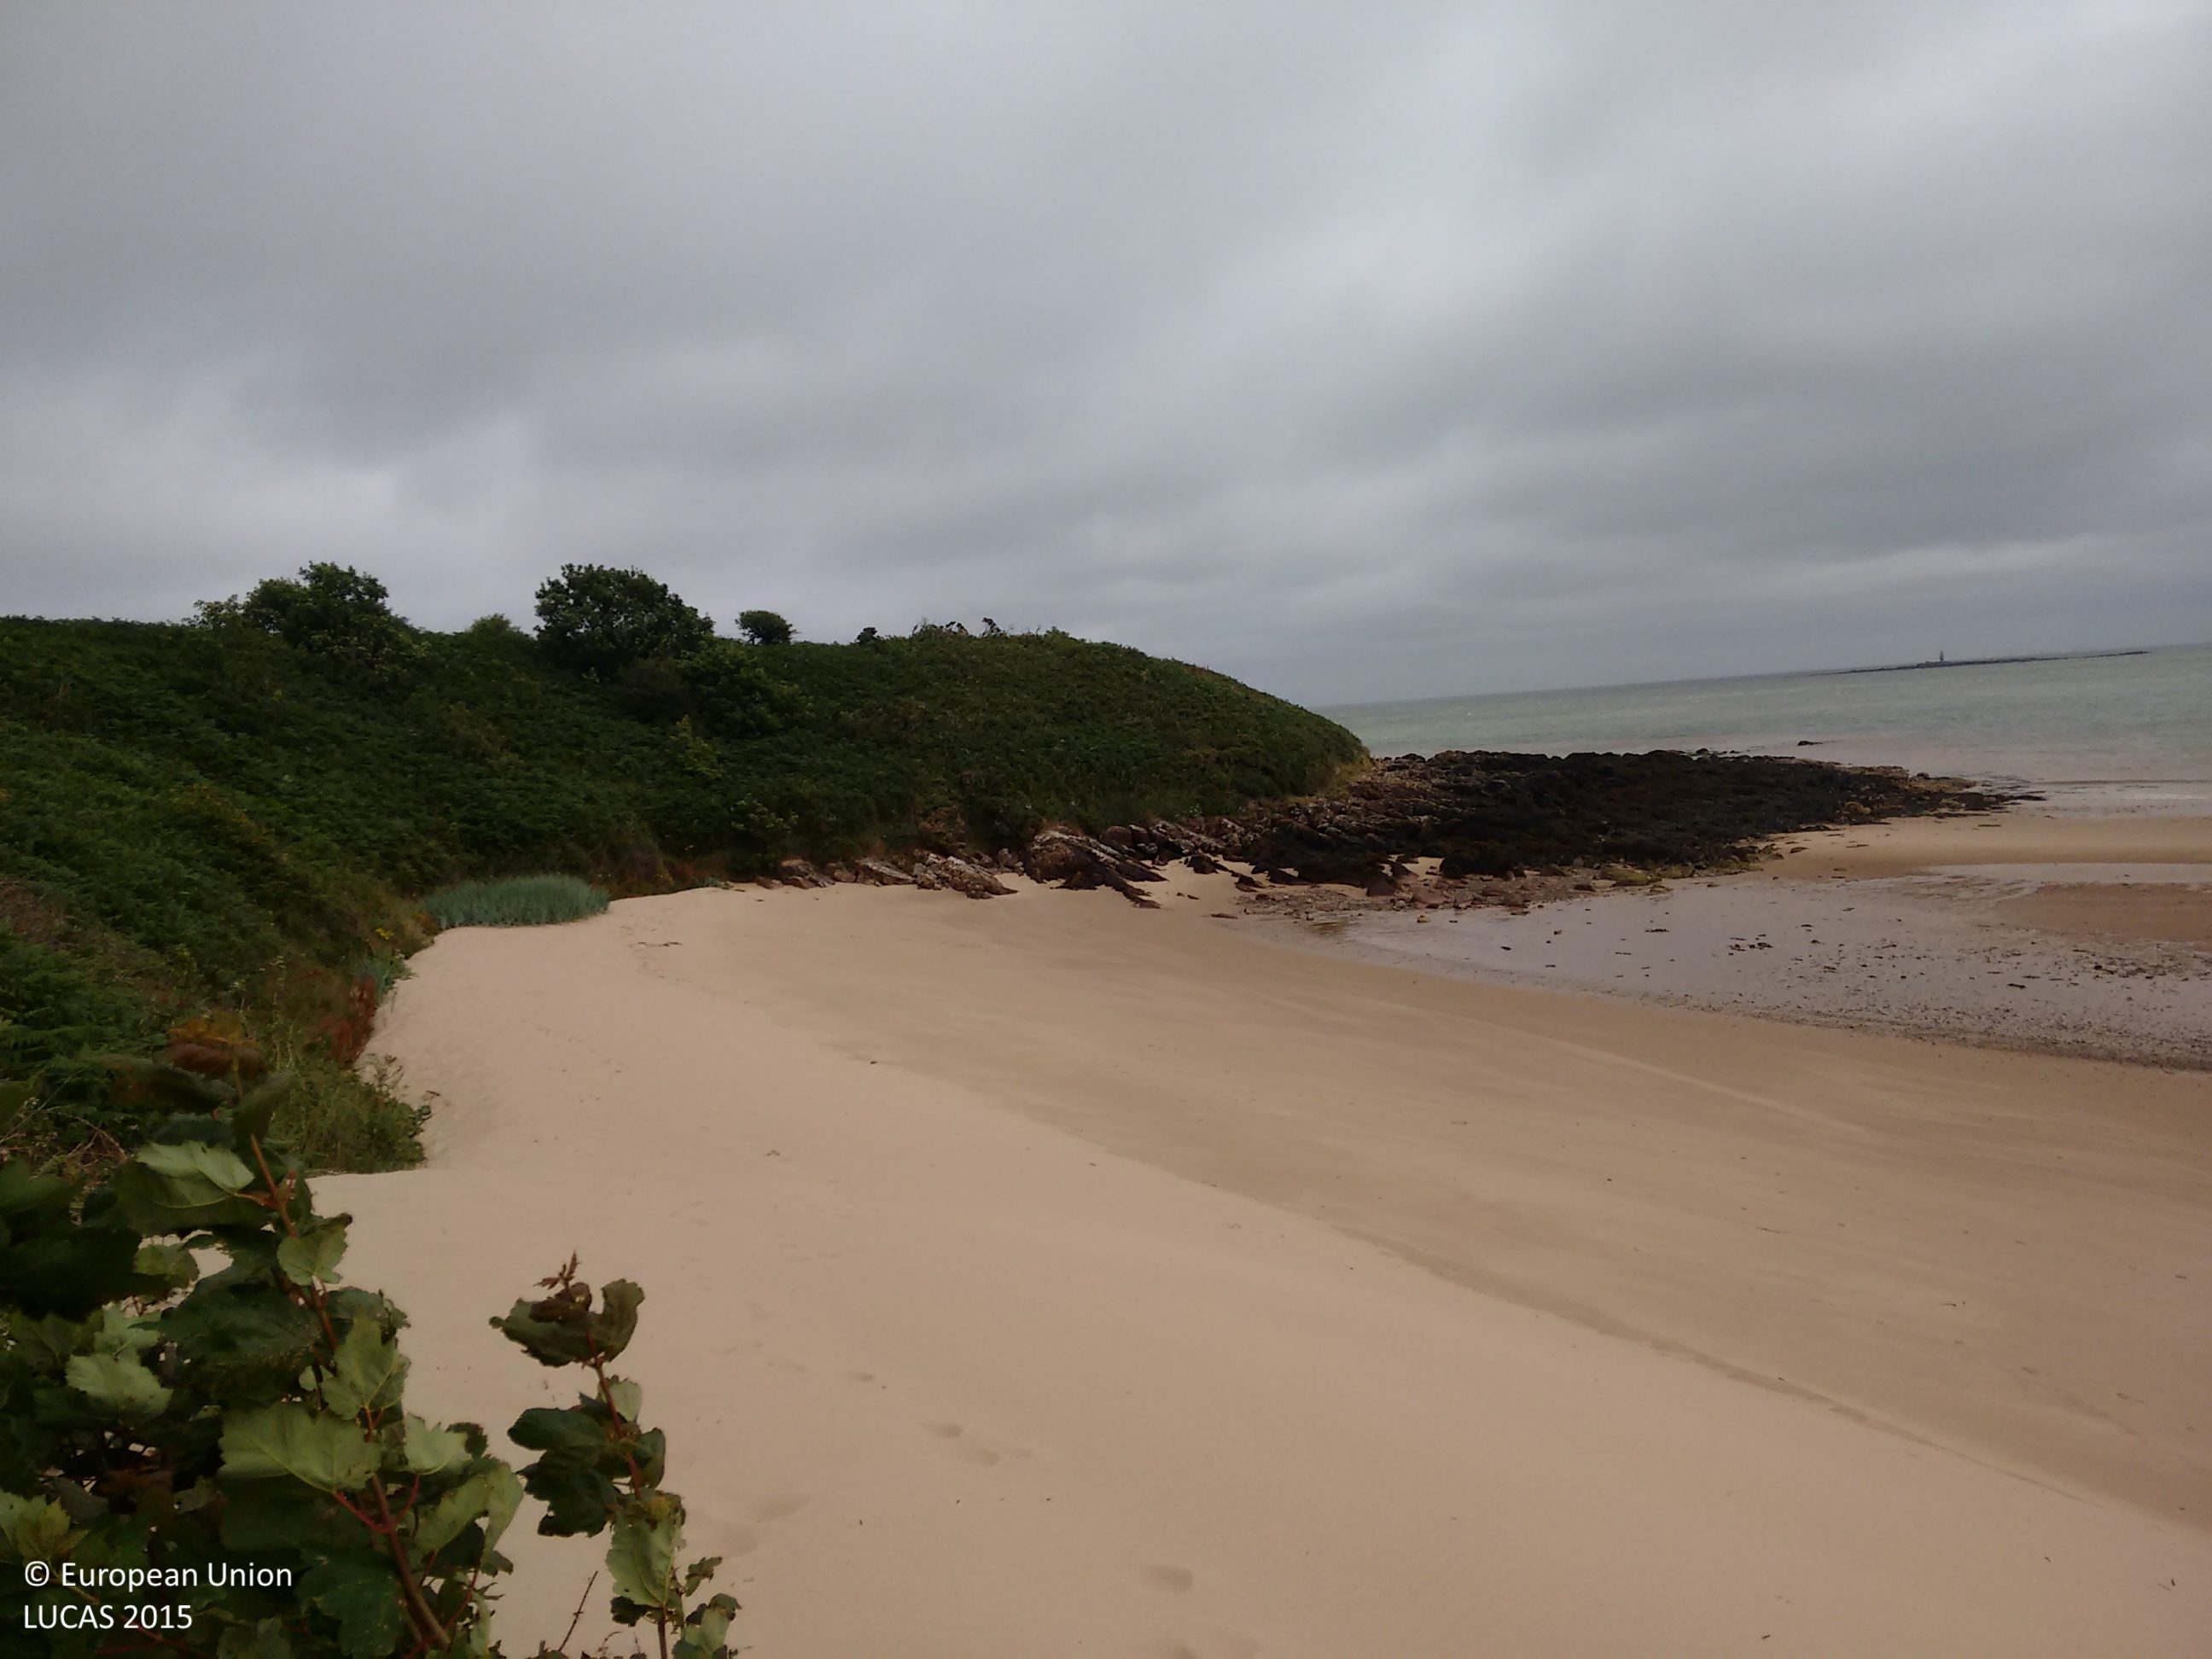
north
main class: Shrubland
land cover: Shrubland without tree cover
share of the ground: > 75 %
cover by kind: shrubs 100 %
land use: Semi-natural and natural areas not in use
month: August
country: GB
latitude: 53.3728
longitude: -4.2735
